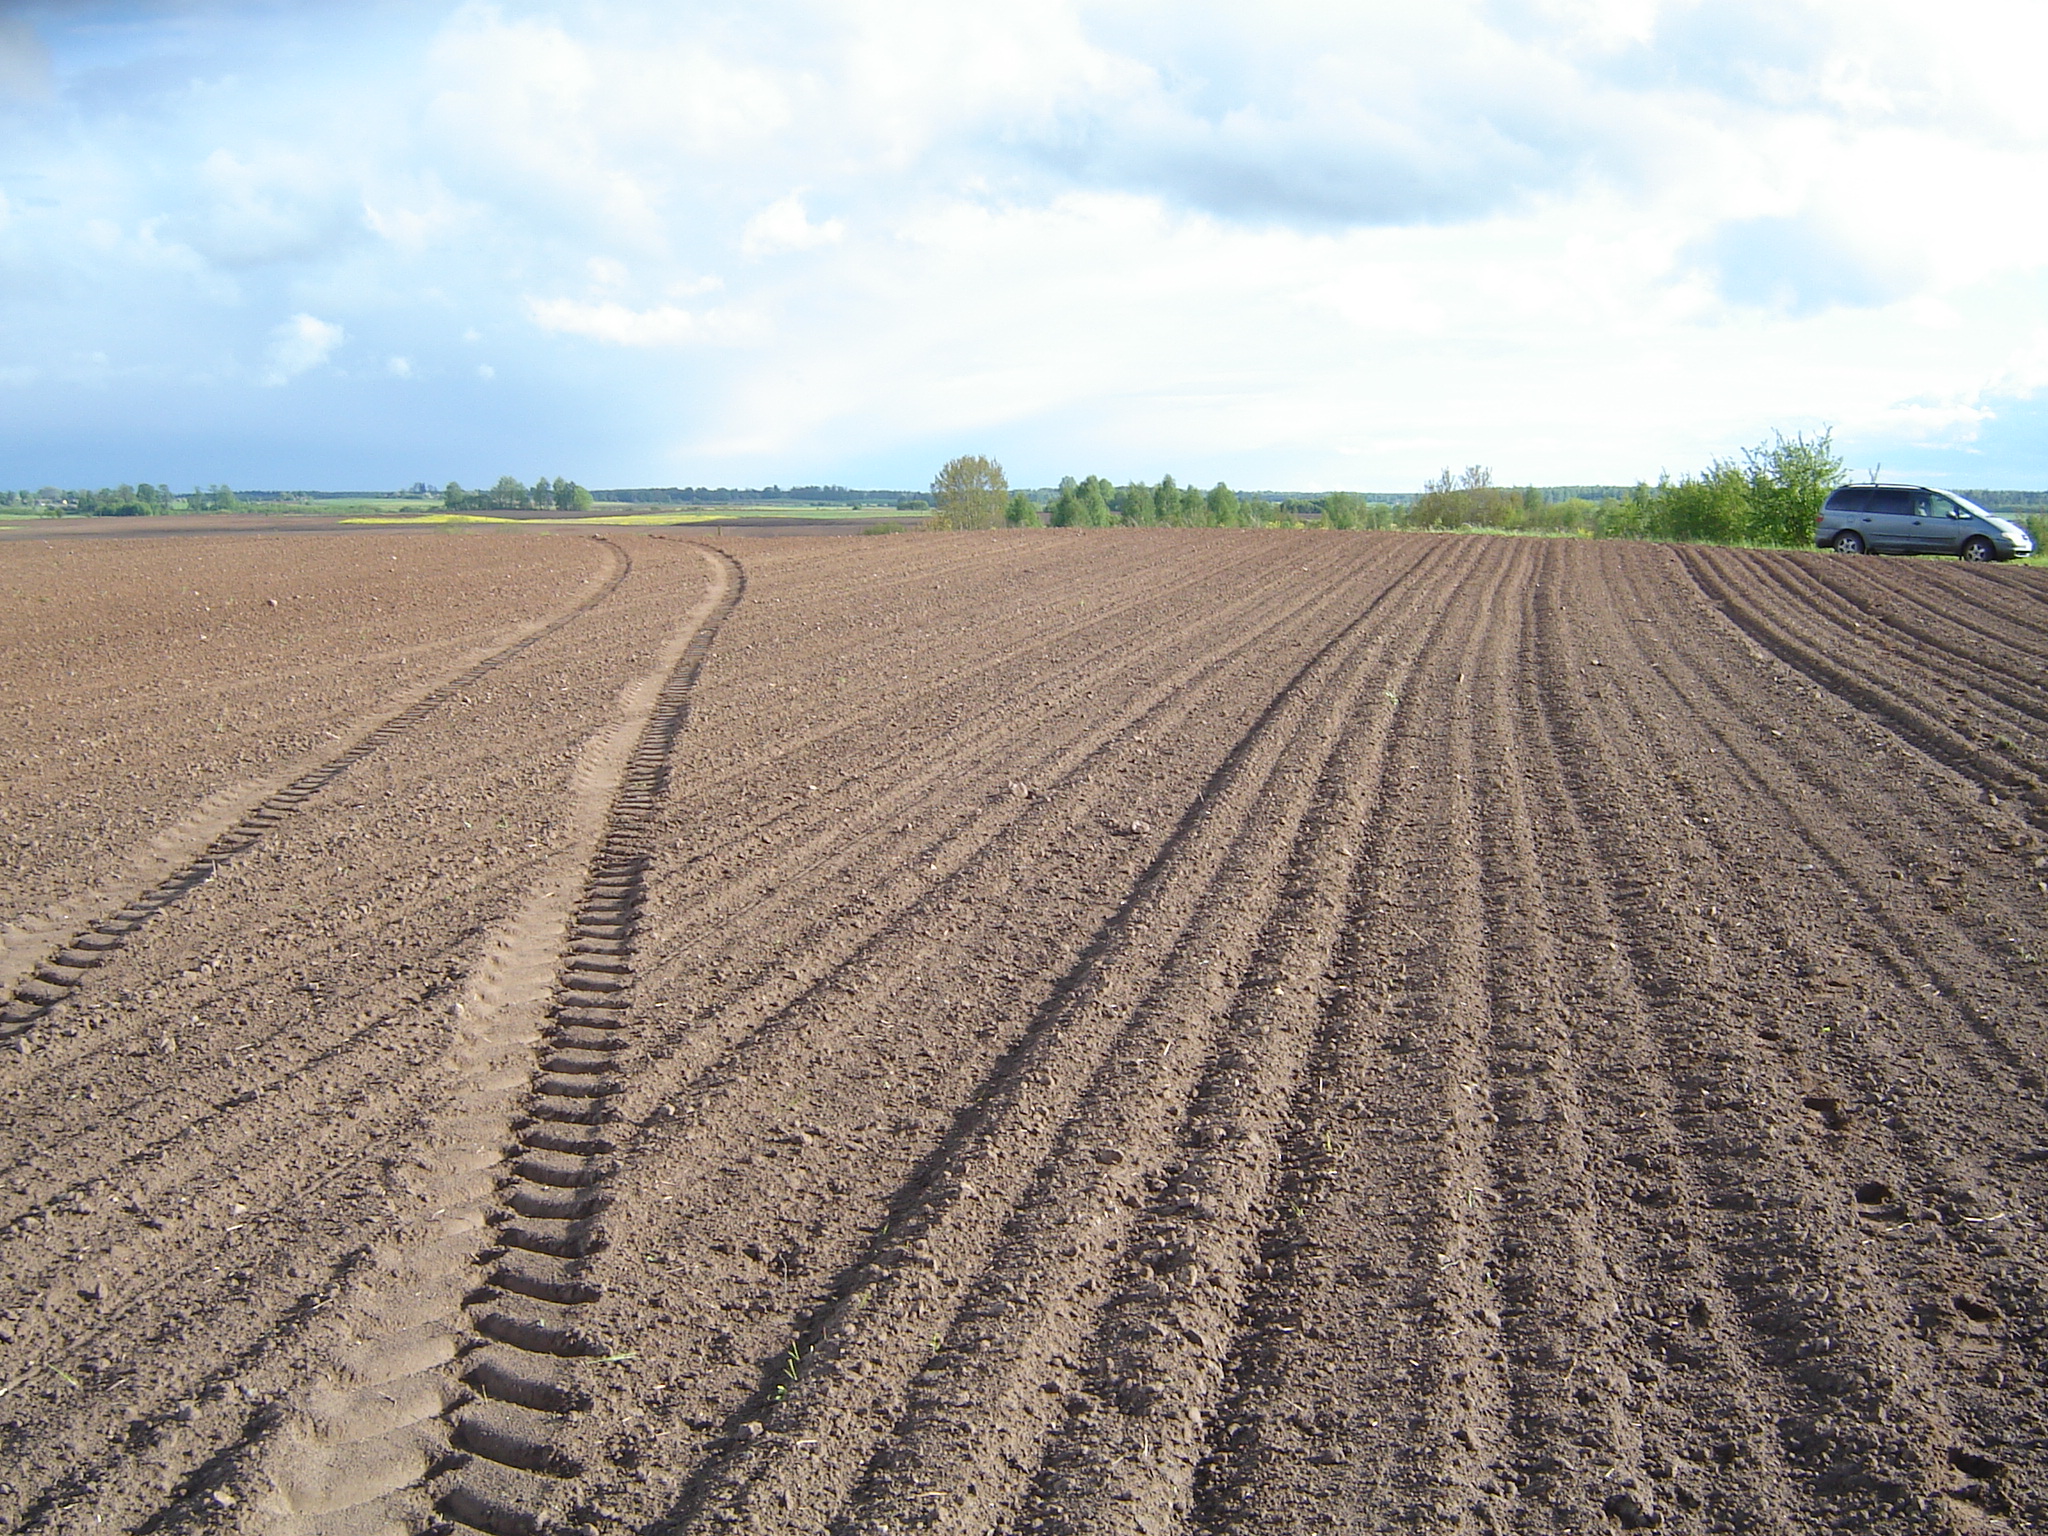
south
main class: Cropland
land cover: Oats
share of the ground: < 10 %
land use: Agriculture (excluding fallow land and kitchen gardens)
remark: Tilled/Sowed
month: May
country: LT
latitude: 56.0658
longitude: 25.3285
